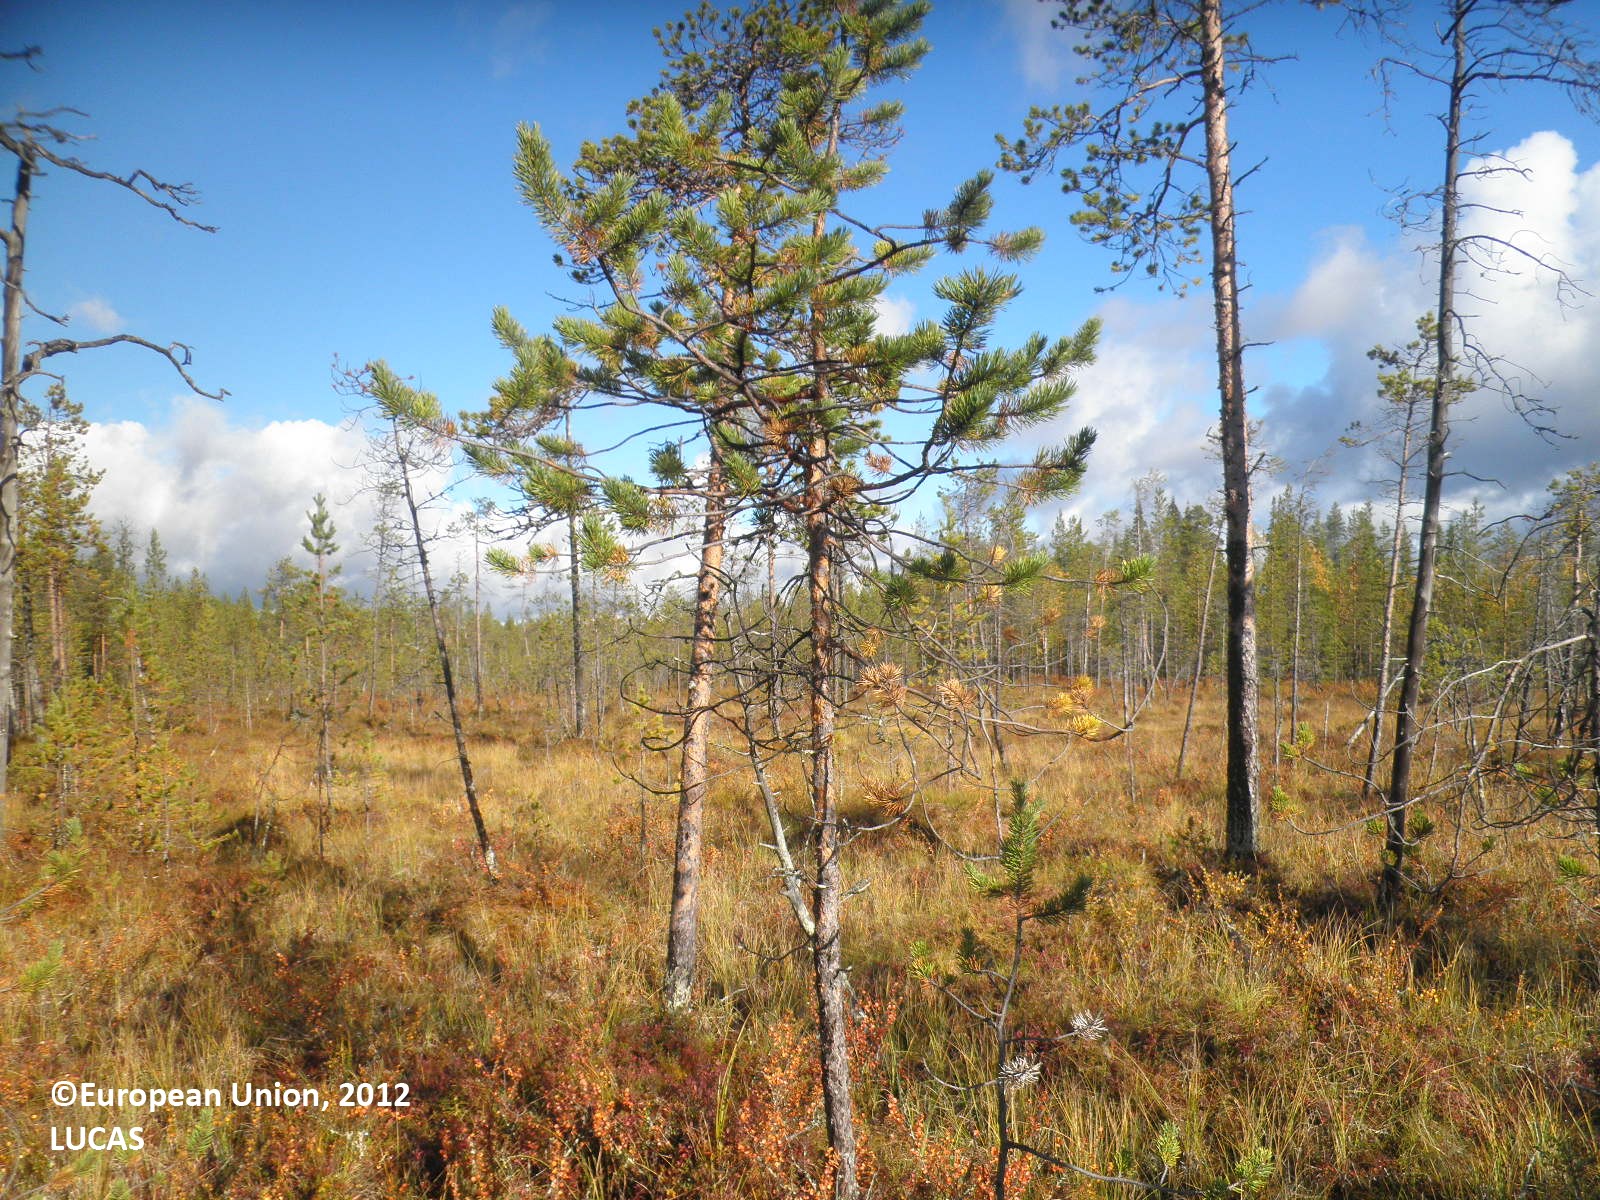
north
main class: Woodland
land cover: Pine dominated coniferous woodland
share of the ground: 10 - 25 %
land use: Forestry
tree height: > 5 m
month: September
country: FI
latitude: 67.4527
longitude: 28.4738
